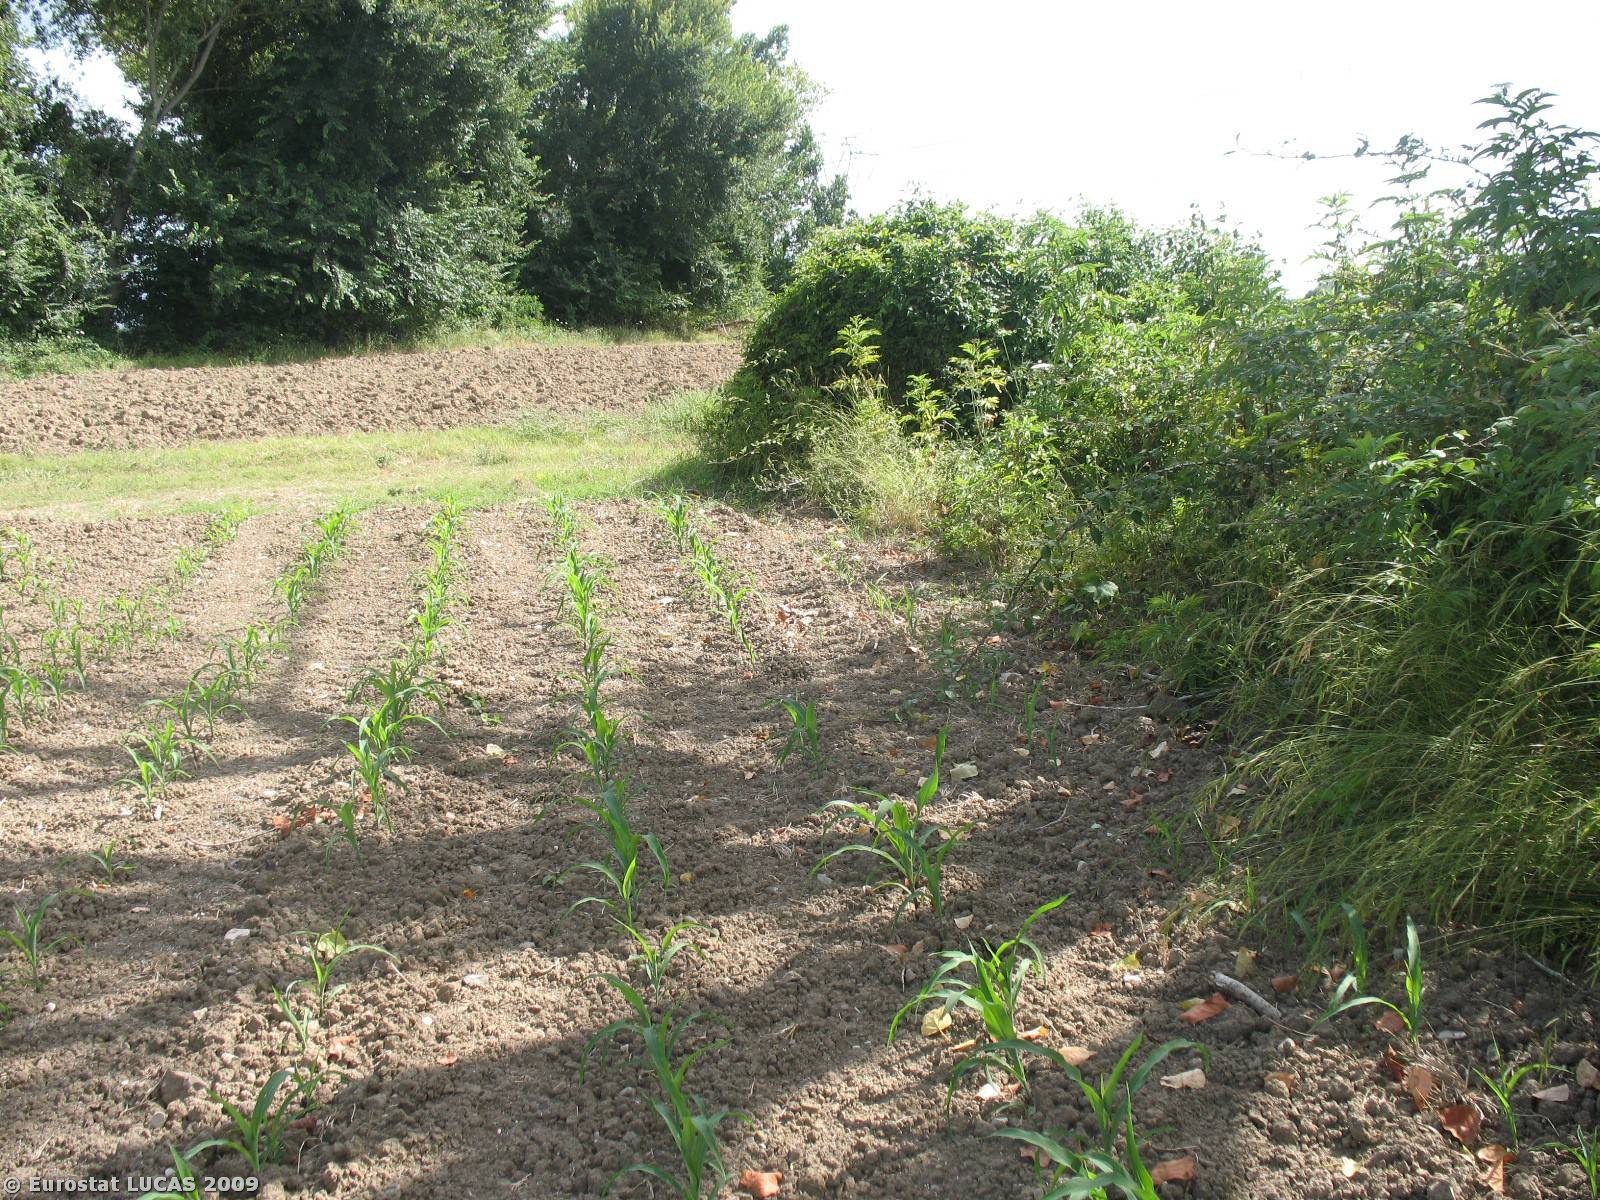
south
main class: Cropland
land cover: Maize
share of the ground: 25 - 50 %
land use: Agriculture (excluding fallow land and kitchen gardens)
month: July
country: IT
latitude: 40.5364
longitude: 15.0436
